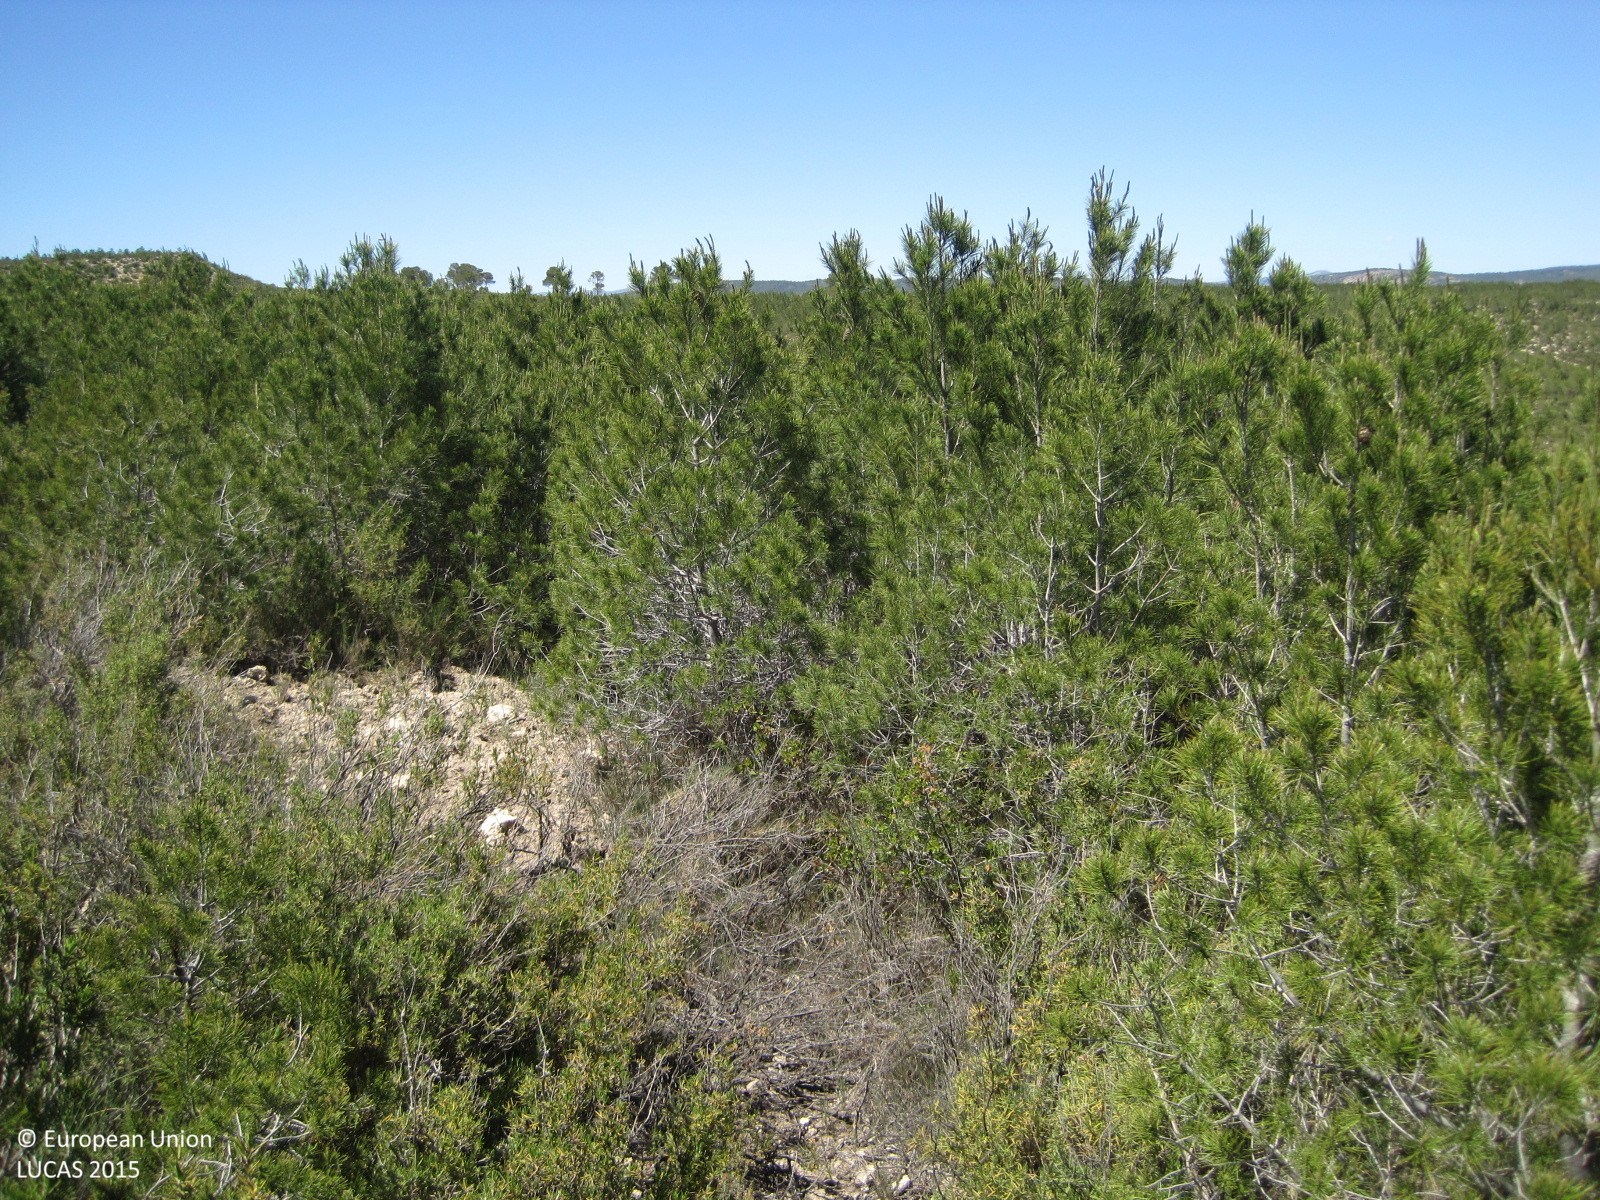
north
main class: Woodland
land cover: Pine dominated coniferous woodland
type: coniferous forest of the mediterranean region
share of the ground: > 75 %
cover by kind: coniferous forest trees 90 %, shrubs 10 %
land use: Forestry
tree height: < 5 m
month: May
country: ES
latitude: 39.3814
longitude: -1.0868
